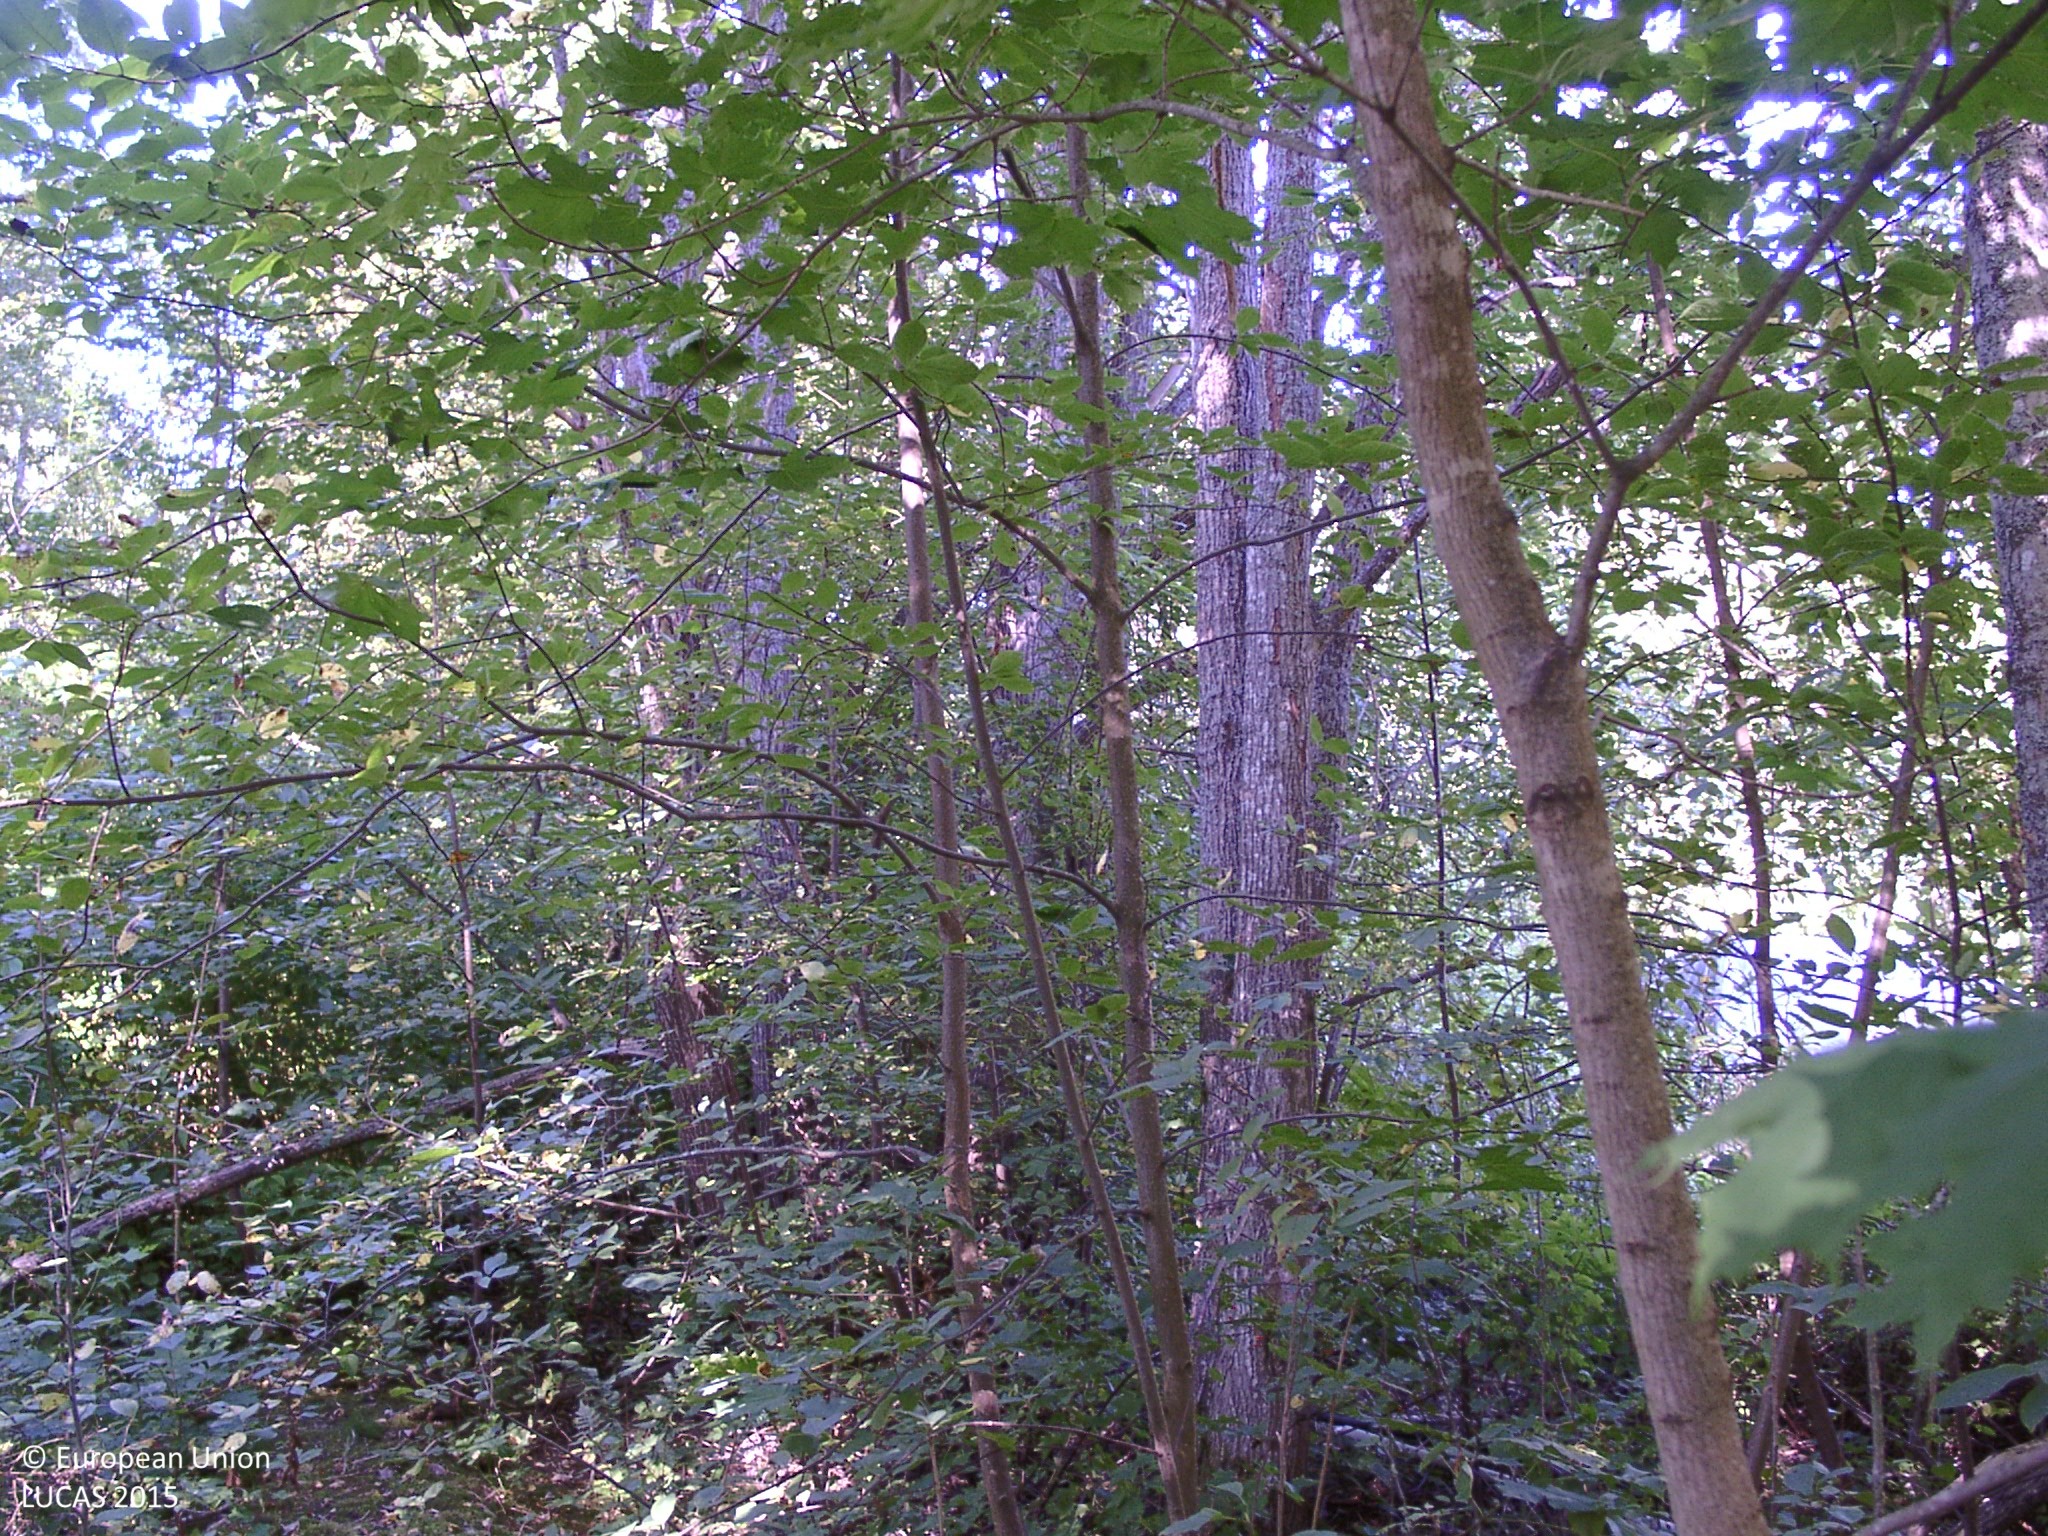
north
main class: Woodland
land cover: Broadleaved woodland
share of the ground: 50 - 75 %
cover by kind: broadleaved forest trees 50 %, shrubs 30 %, coniferous forest trees 15 %, herbaceous plants 5 %
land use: Semi-natural and natural areas not in use
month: August
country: FI
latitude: 61.8583
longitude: 25.1429
